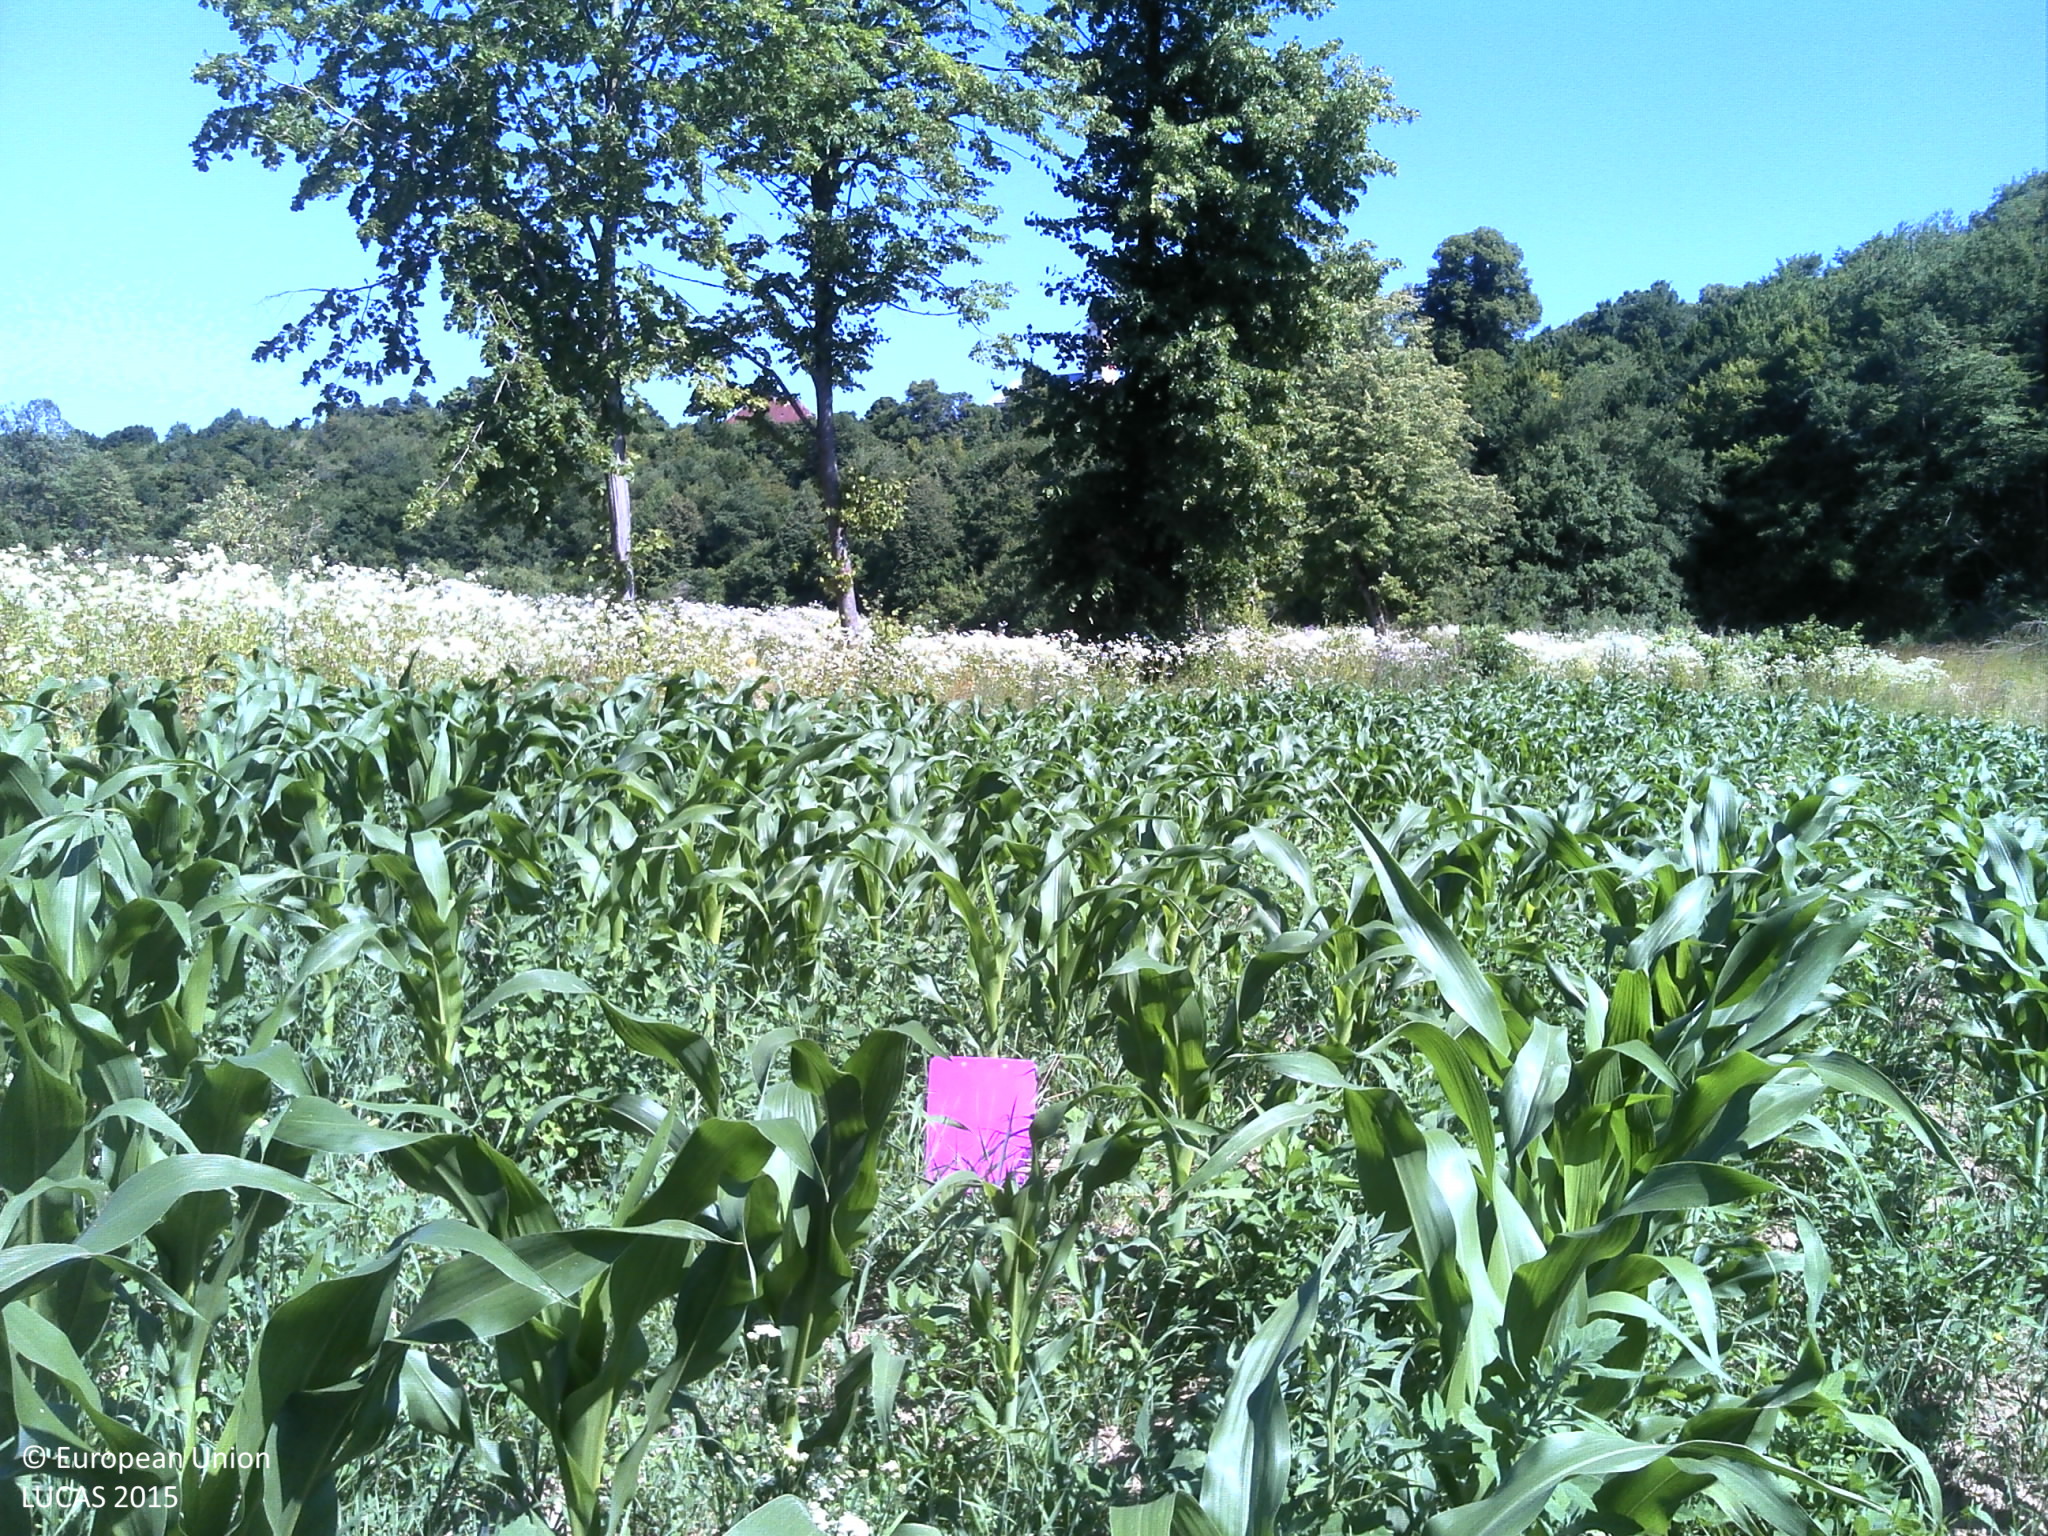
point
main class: Cropland
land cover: Maize
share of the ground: > 75 %
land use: Agriculture (excluding fallow land and kitchen gardens)
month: July
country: HR
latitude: 44.9452
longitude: 15.1526
